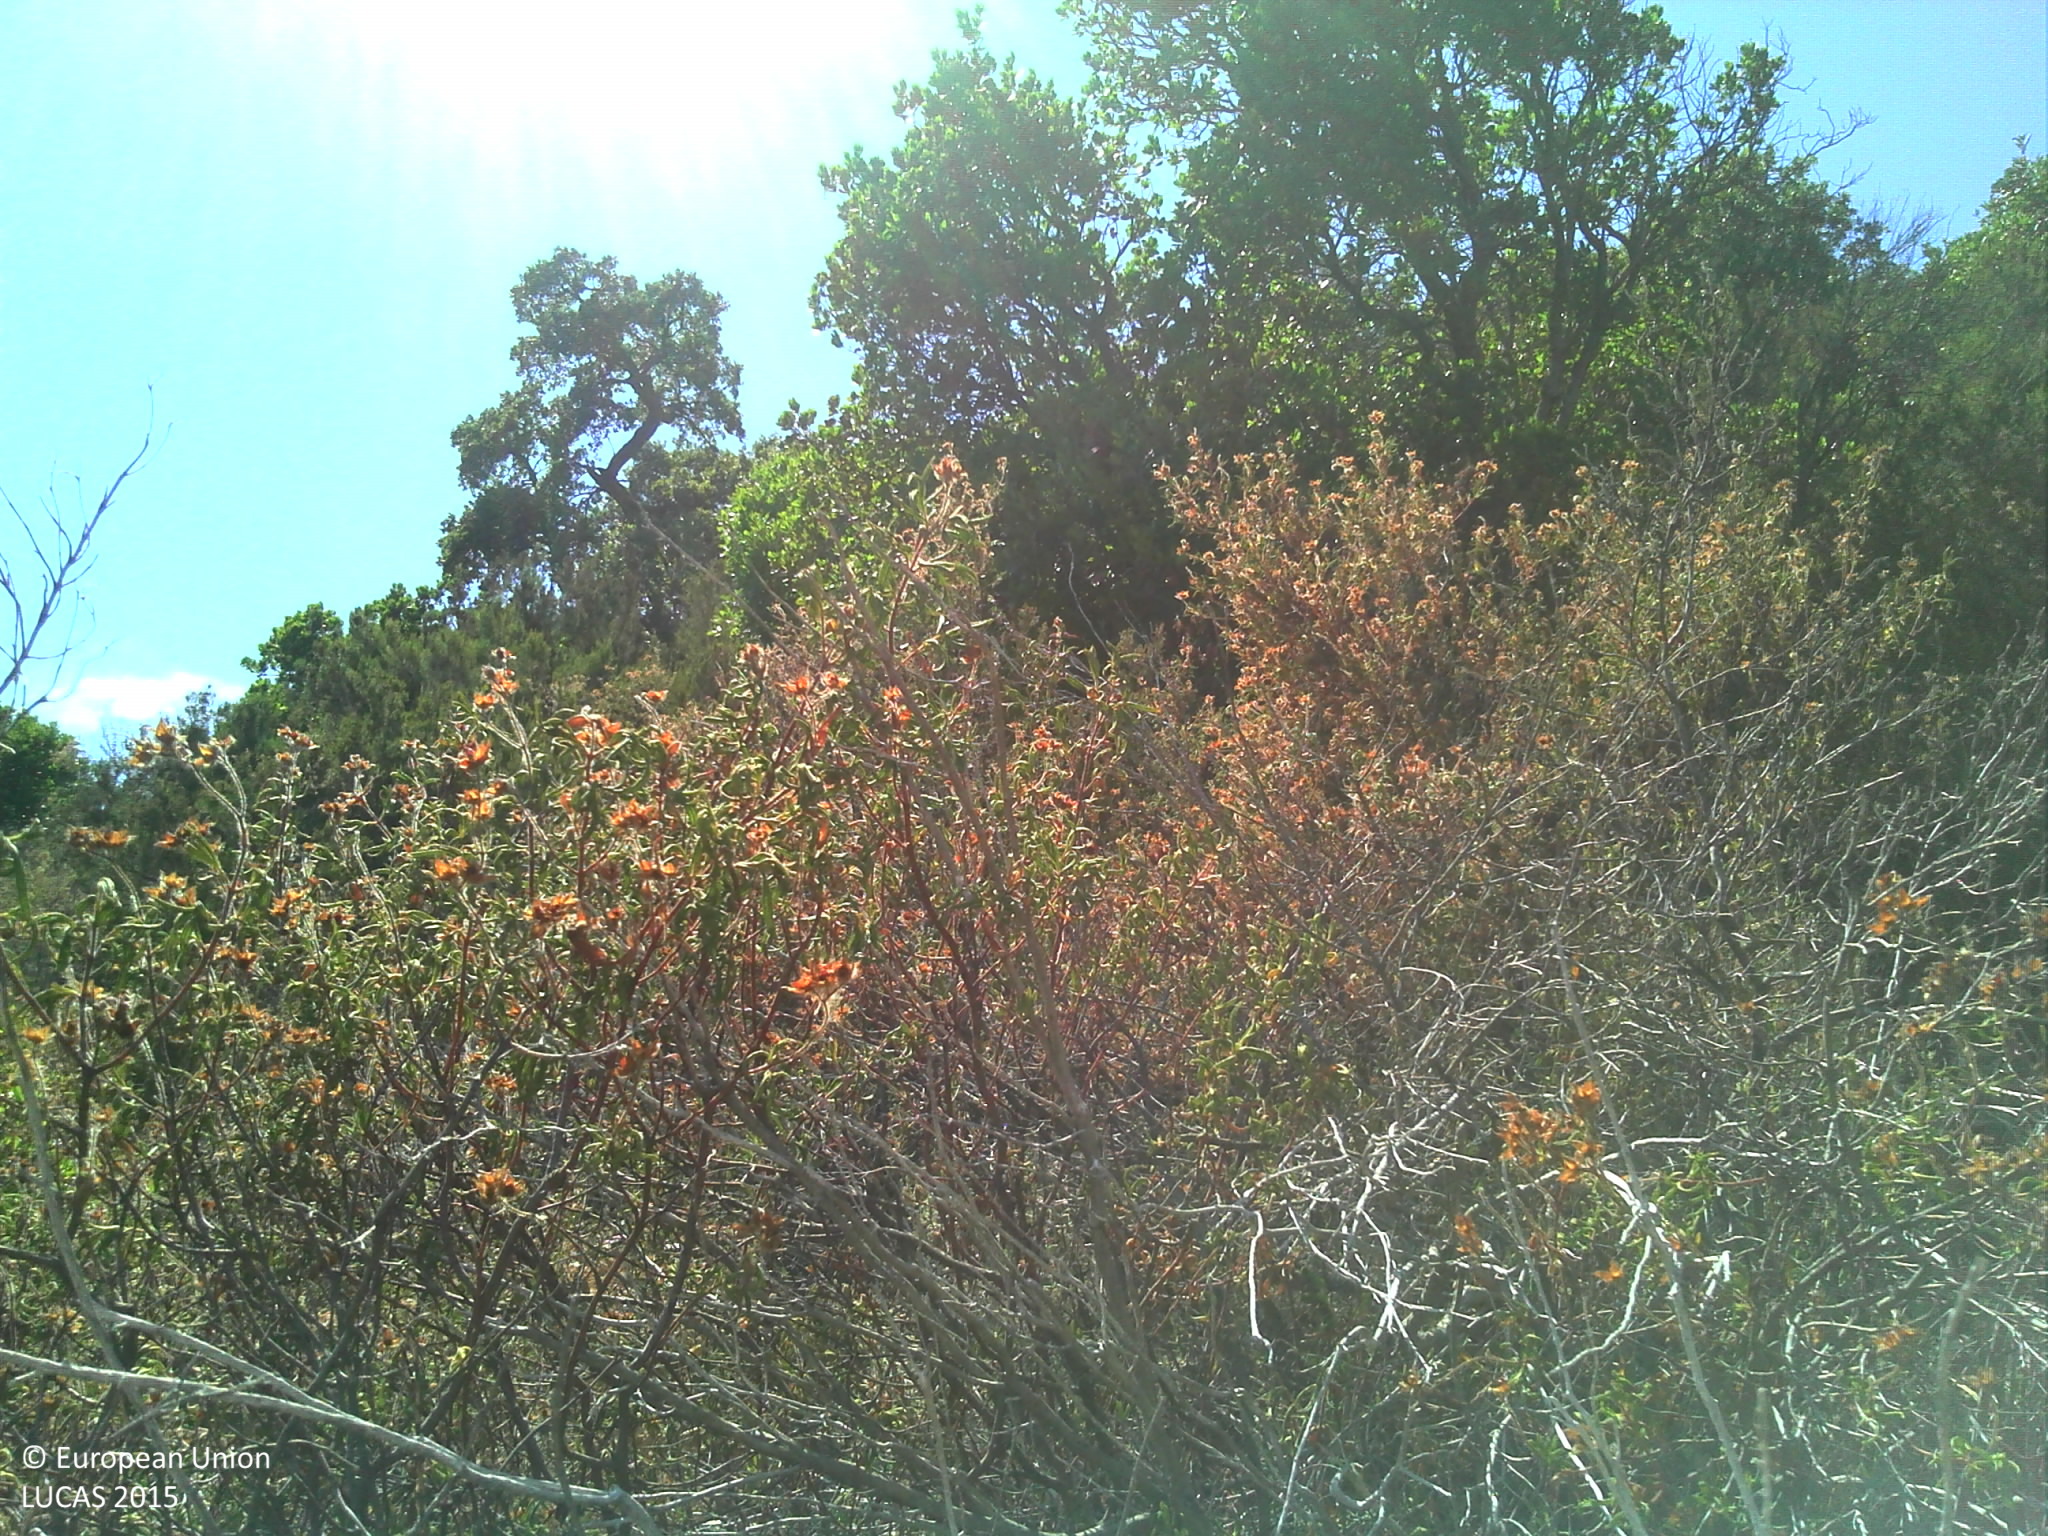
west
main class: Shrubland
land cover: Shrubland without tree cover
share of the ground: > 75 %
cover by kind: shrubs 95 %, unconsolidated bare surface 5 %
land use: Semi-natural and natural areas not in use
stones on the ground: > 50 %
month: July
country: FR
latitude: 43.1470
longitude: 6.3085
